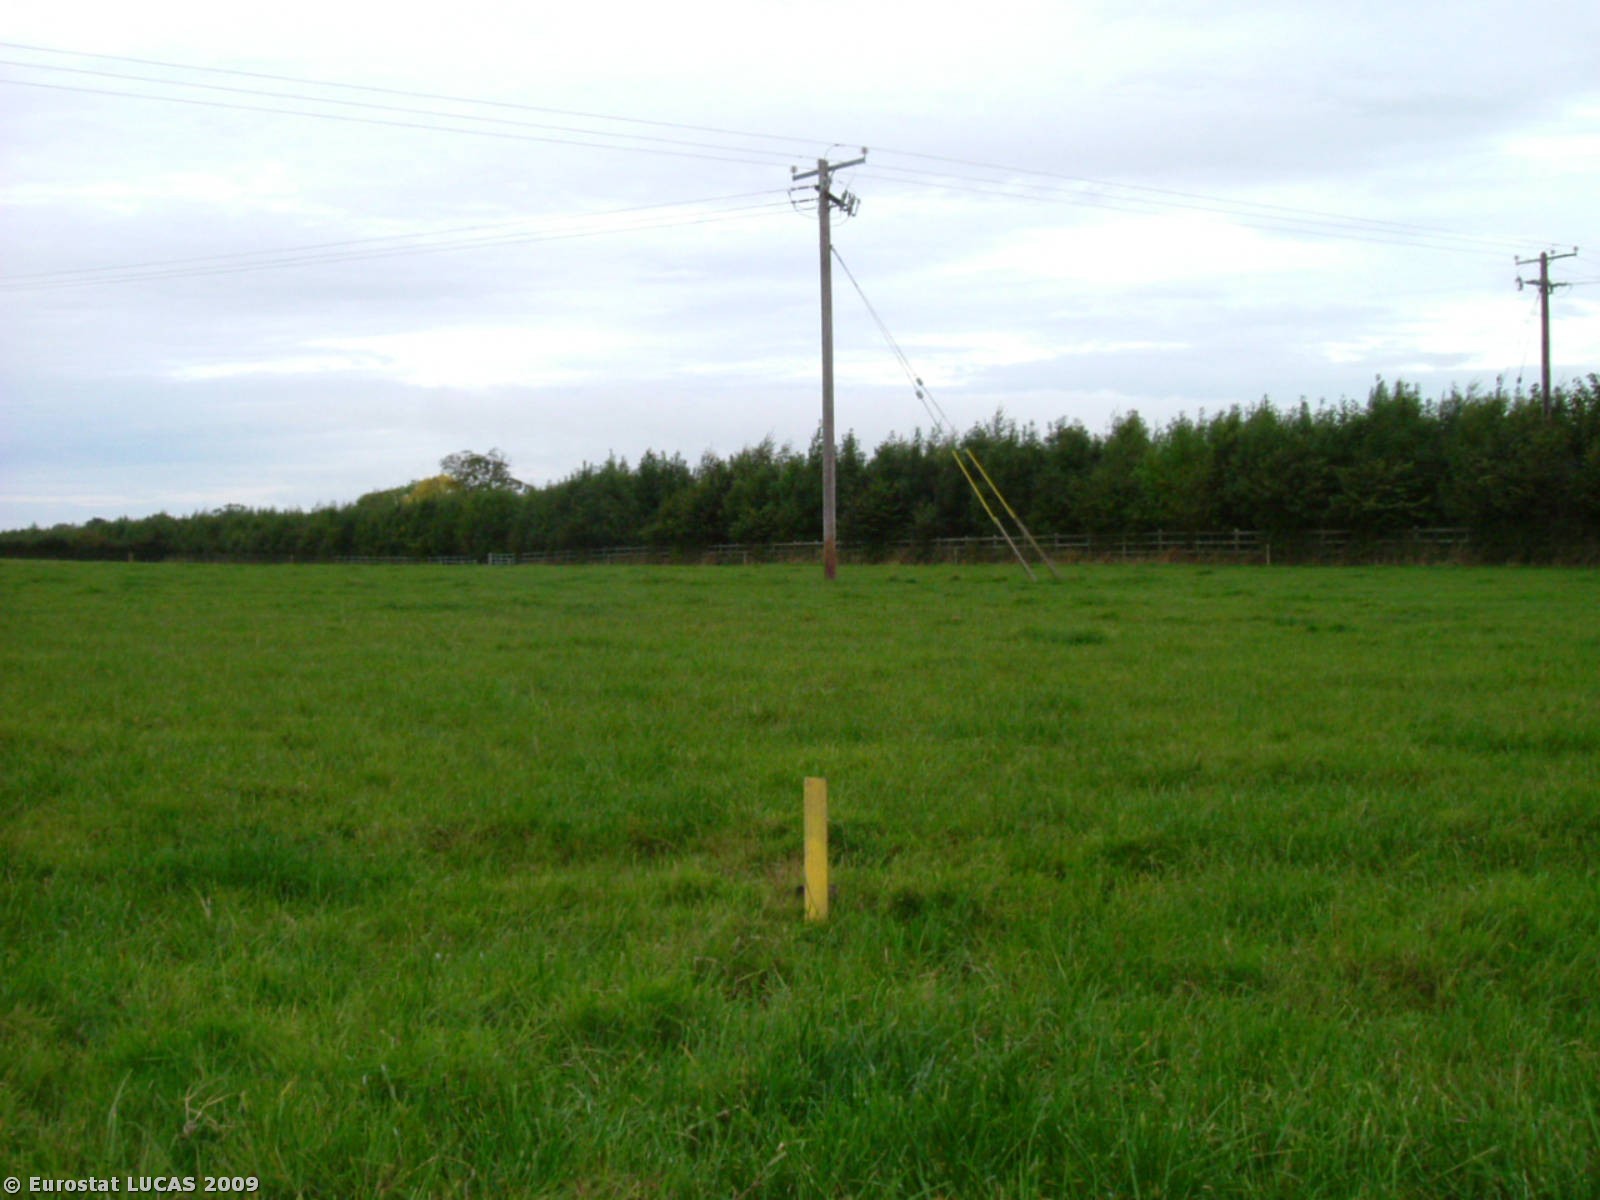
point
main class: Grassland
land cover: Grassland without tree/shrub cover
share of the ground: > 75 %
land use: Agriculture (excluding fallow land and kitchen gardens)
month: September
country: IE
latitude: 52.8677
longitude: -8.2331
